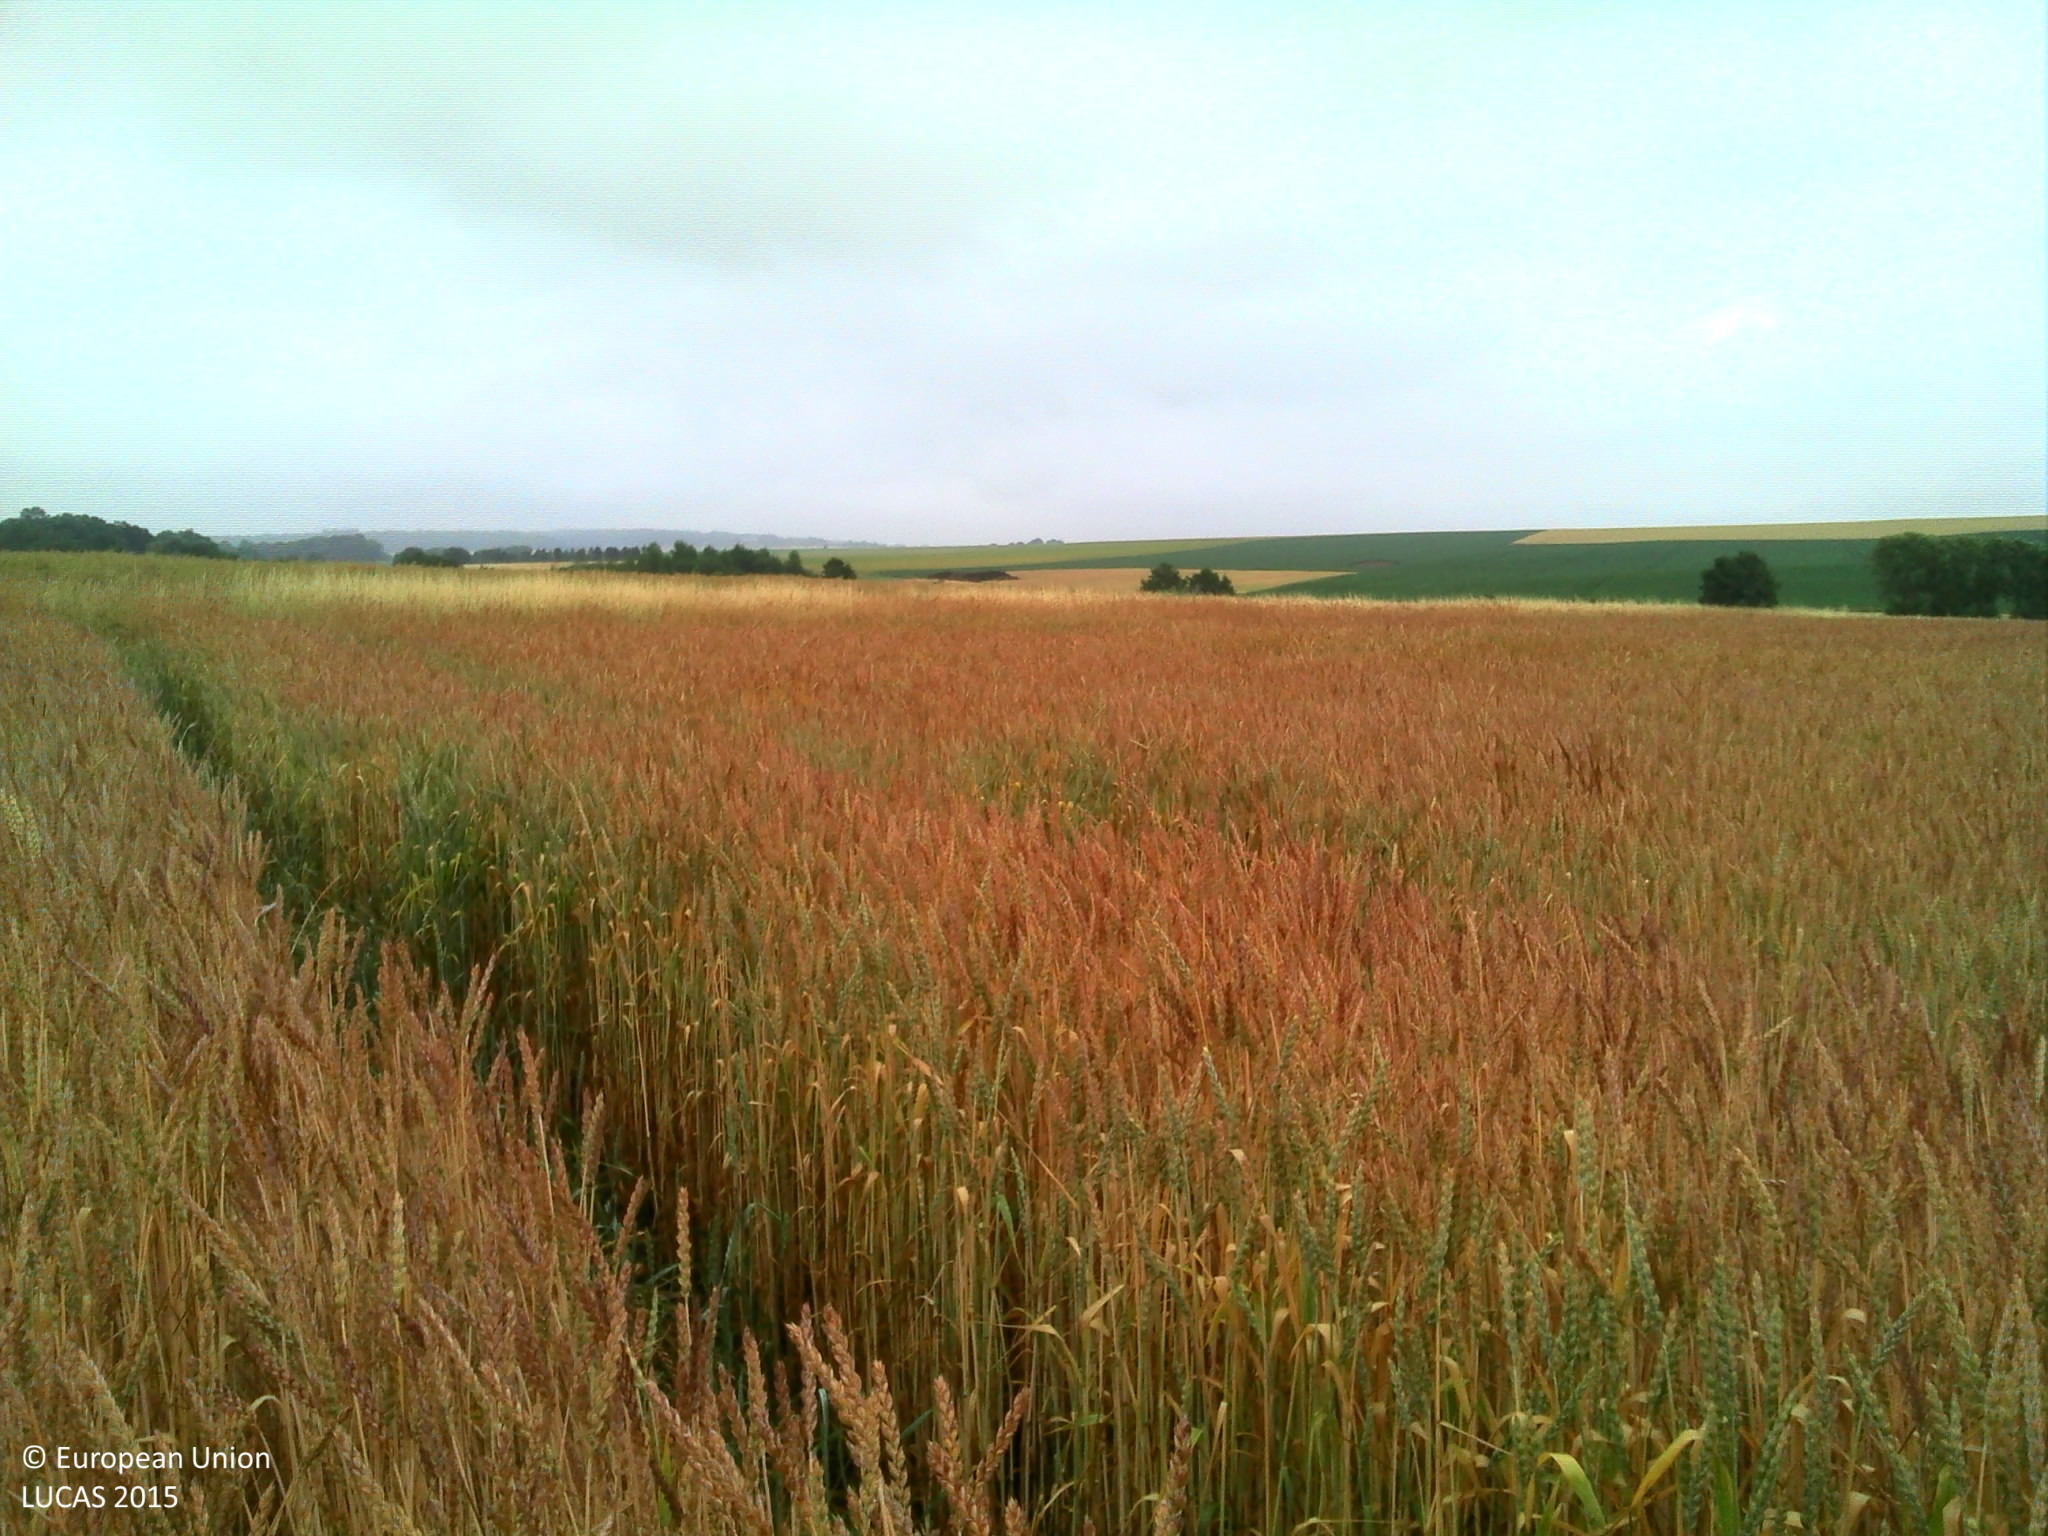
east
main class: Cropland
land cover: Common wheat
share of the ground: > 75 %
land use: Agriculture (excluding fallow land and kitchen gardens)
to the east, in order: Common wheat; Grassland without tree/shrub cover; Tracks; Grass margins; Rape and turnip rape
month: July
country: BE
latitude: 50.2794
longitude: 4.3683
